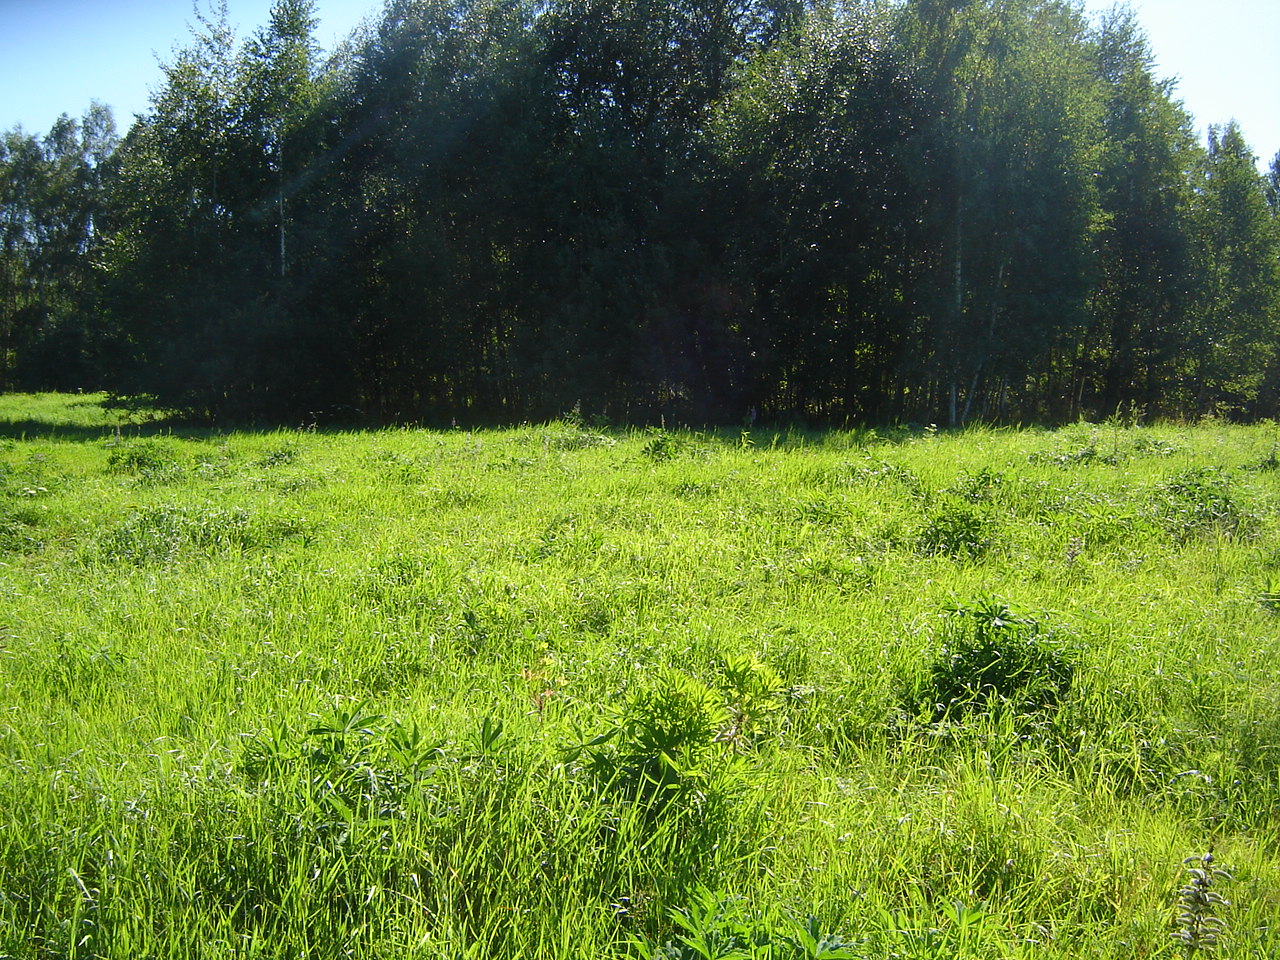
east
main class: Grassland
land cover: Grassland without tree/shrub cover
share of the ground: > 75 %
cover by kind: herbaceous plants 100 %
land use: Agriculture (excluding fallow land and kitchen gardens)
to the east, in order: Grassland without tree/shrub cover; Broadleaved woodland; Grassland without tree/shrub cover; Broadleaved woodland; Inland marshes; Broadleaved woodland
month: August
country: LT
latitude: 54.9763
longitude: 25.3876
